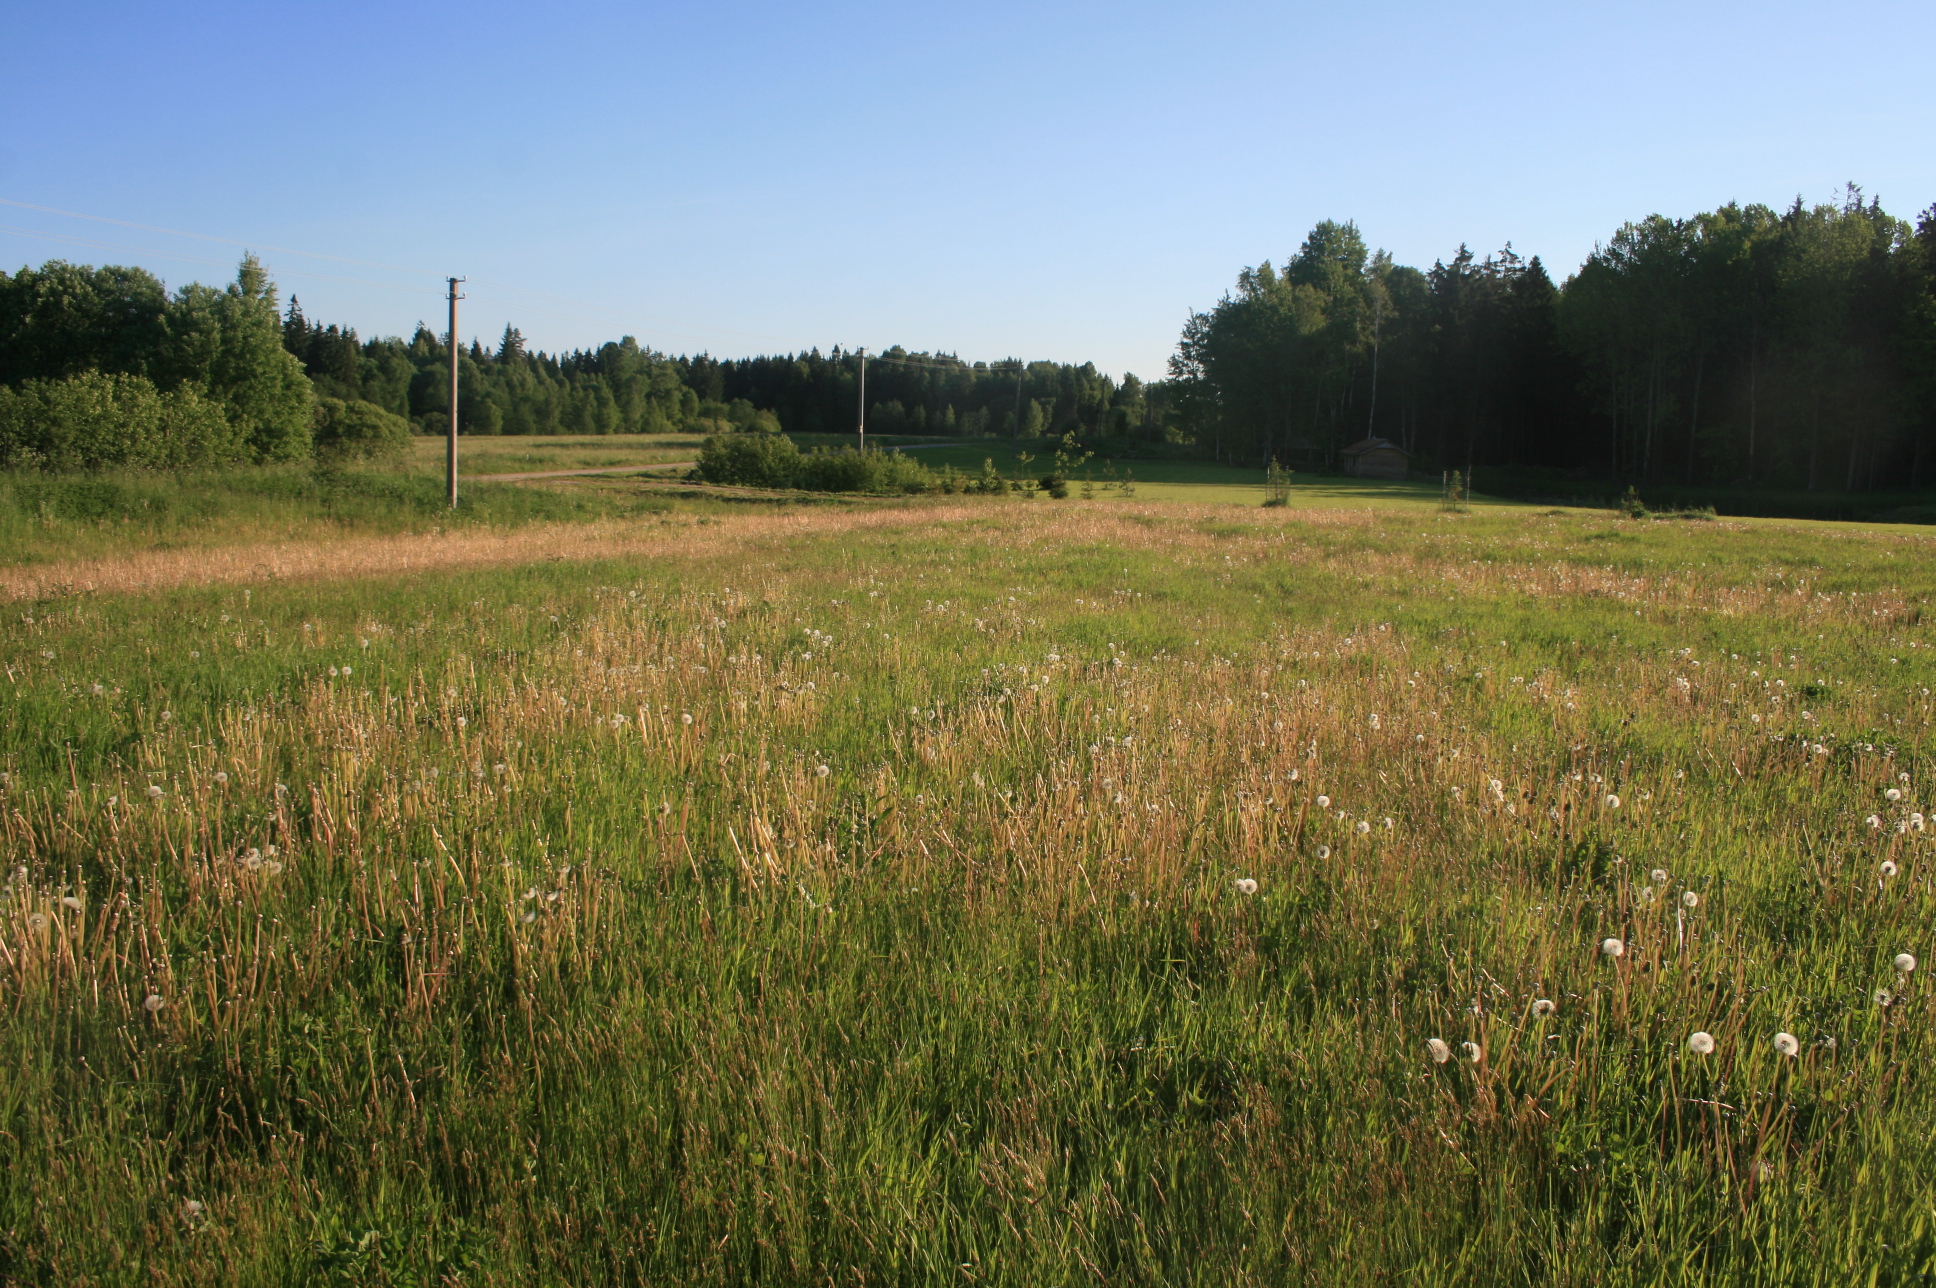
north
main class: Grassland
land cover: Grassland without tree/shrub cover
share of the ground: > 75 %
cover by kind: herbaceous plants 100 %
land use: Agriculture (excluding fallow land and kitchen gardens)
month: June
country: LT
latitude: 55.8984
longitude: 21.9658
